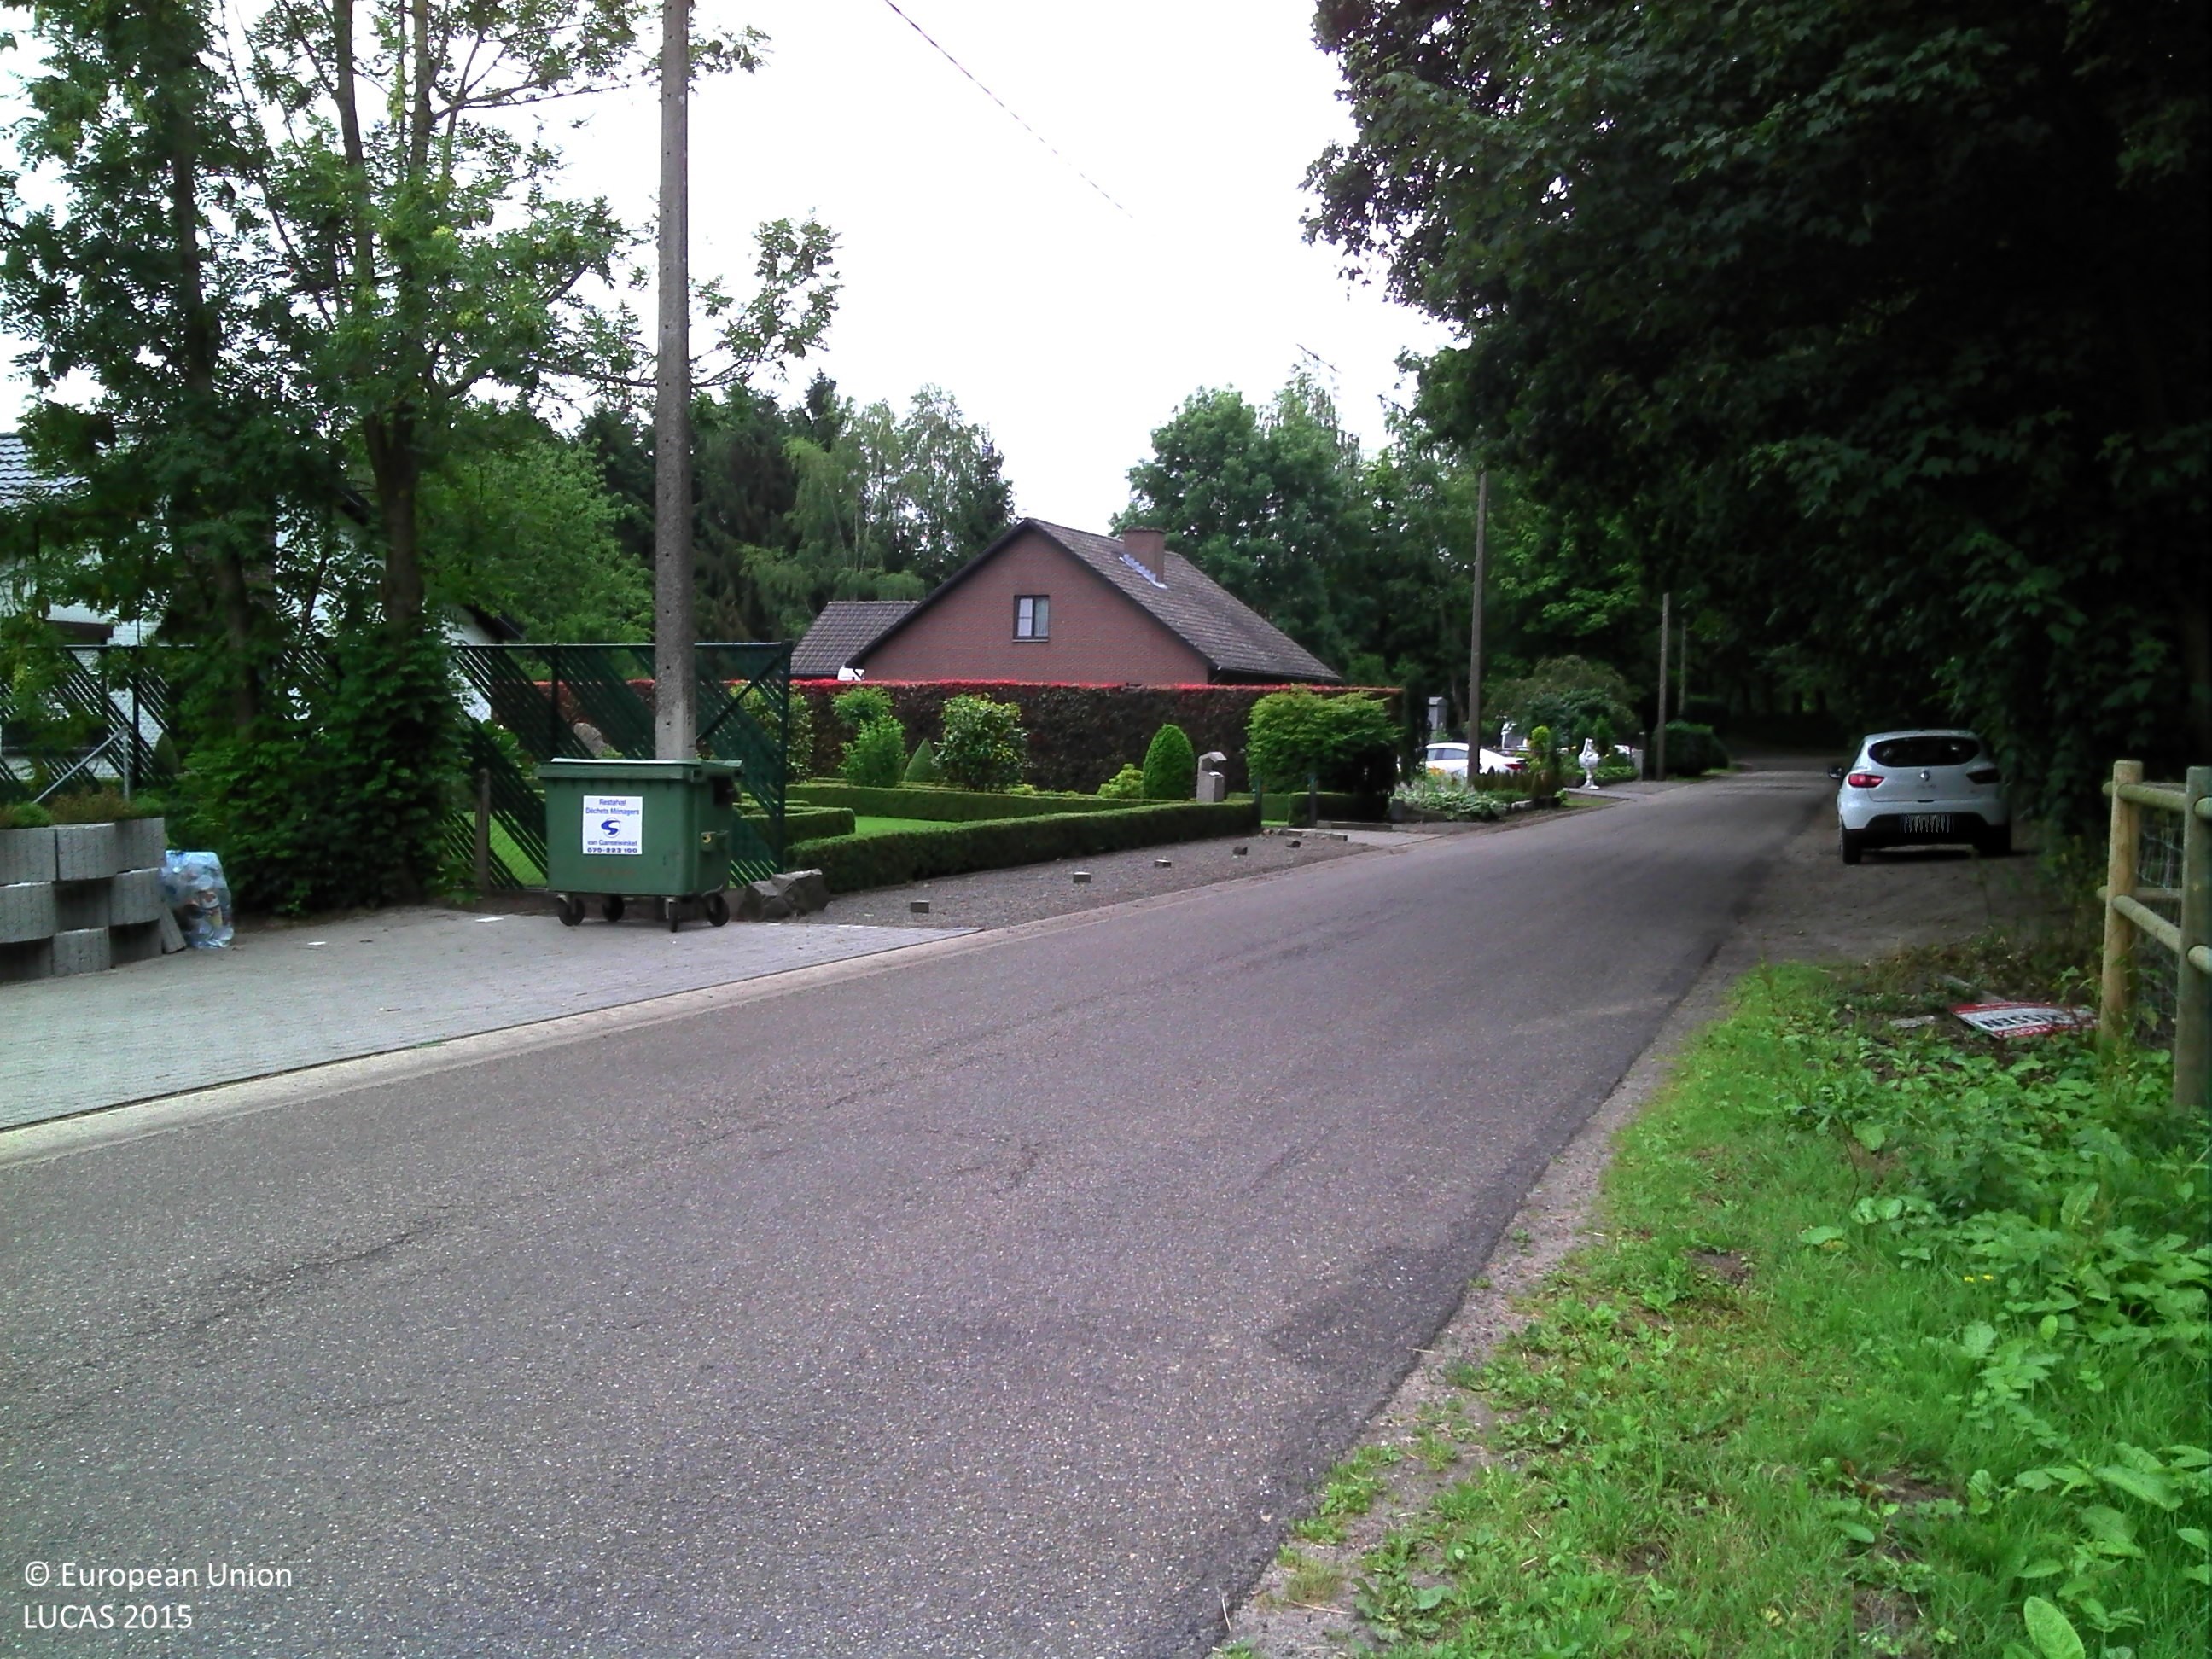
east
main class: Woodland
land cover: Broadleaved woodland
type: mesophytic deciduous forest
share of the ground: > 75 %
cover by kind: broadleaved forest trees 90 %, herbaceous plants 10 %
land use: Semi-natural and natural areas not in use
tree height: > 5 m
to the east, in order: Broadleaved woodland; Artificial constructions in urban areas
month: July
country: BE
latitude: 51.2295
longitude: 5.4871
